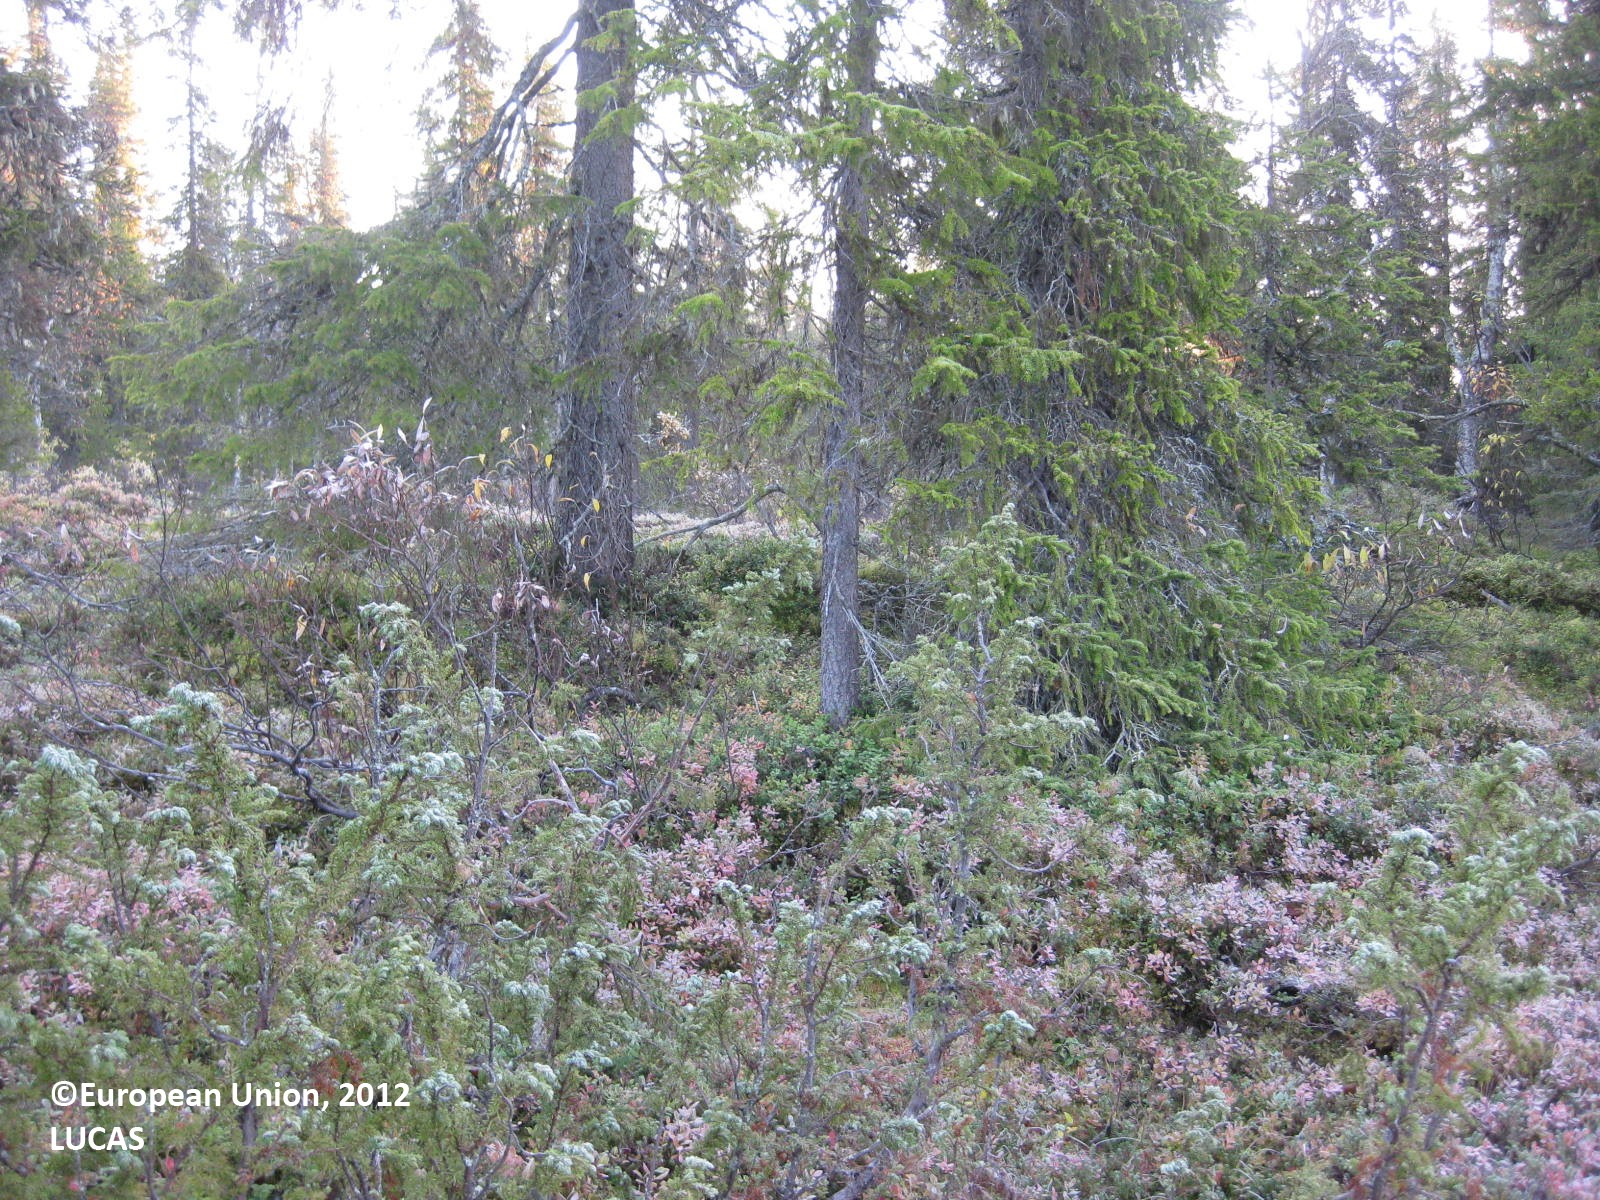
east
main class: Woodland
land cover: Spruce dominated coniferous woodland
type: boreal forest
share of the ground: 50 - 75 %
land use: Semi-natural and natural areas not in use
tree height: > 5 m
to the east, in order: Spruce dominated coniferous woodland
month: September
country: FI
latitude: 68.0290
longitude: 24.0756
